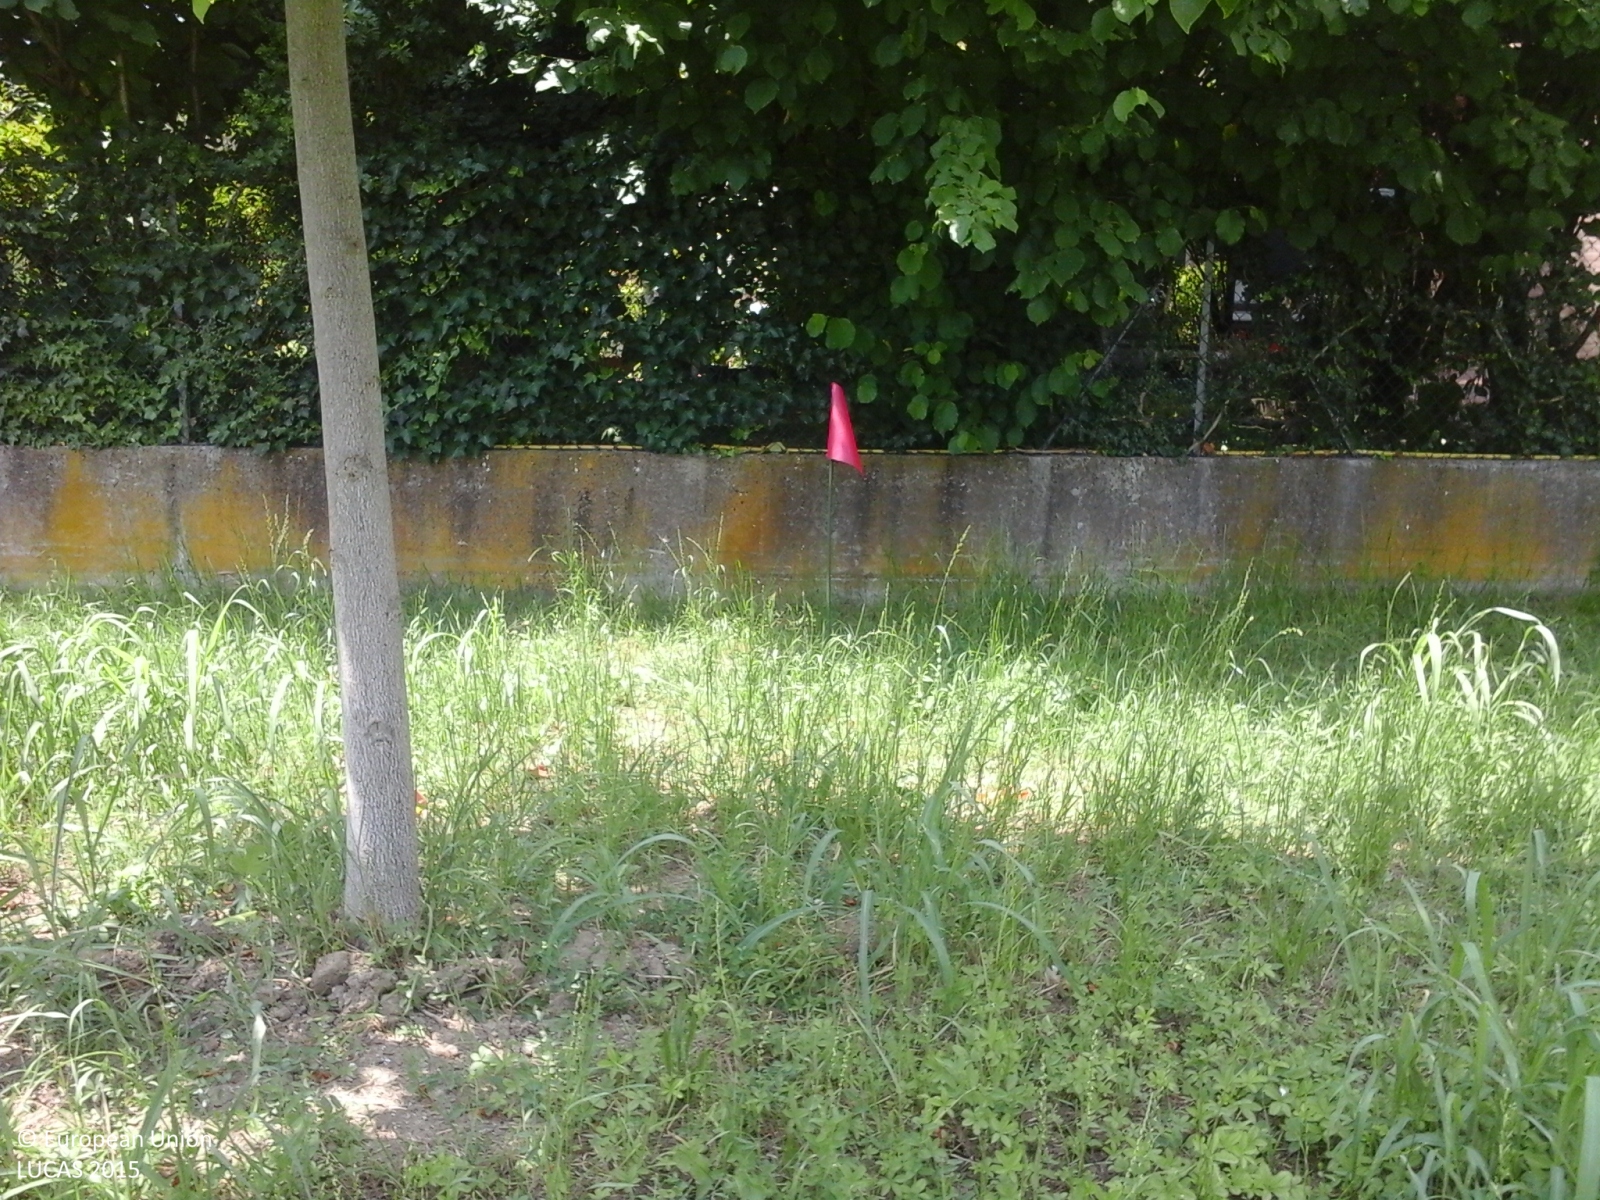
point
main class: Grassland
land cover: Grassland with sparse tree/shrub cover
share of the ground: > 75 %
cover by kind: herbaceous plants 95 %, broadleaved forest trees 5 %
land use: Residential
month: June
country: IT
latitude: 44.7613
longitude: 10.9203
